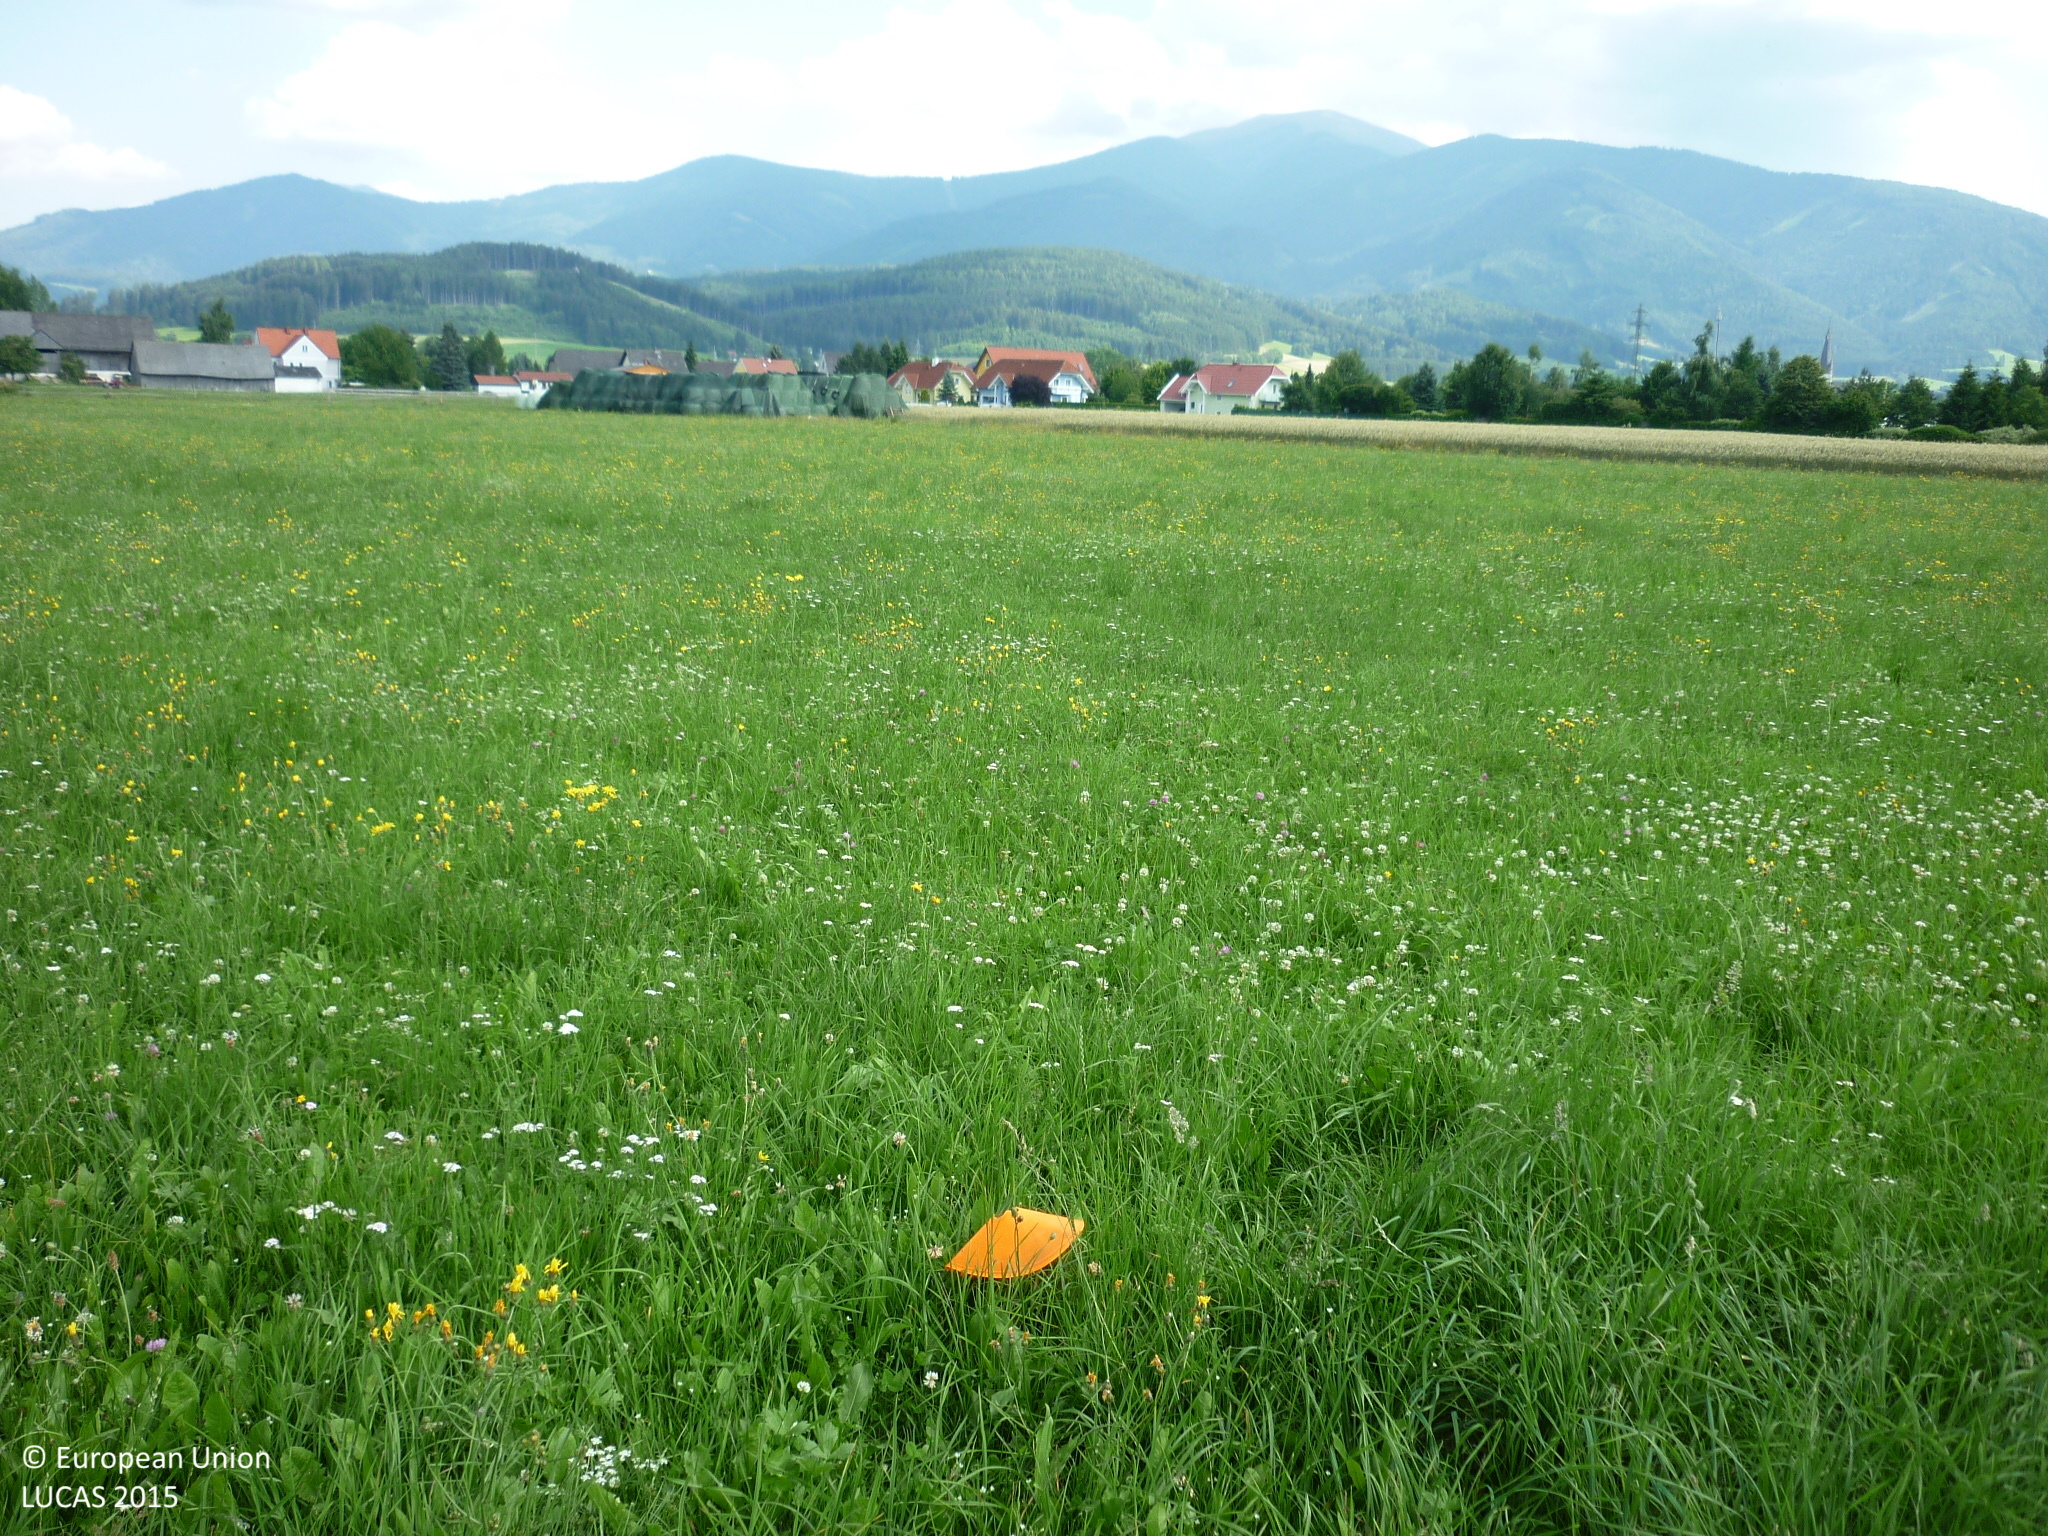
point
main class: Grassland
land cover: Grassland without tree/shrub cover
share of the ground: > 75 %
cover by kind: herbaceous plants 100 %
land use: Agriculture (excluding fallow land and kitchen gardens)
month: July
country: AT
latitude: 47.1663
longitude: 14.7348
